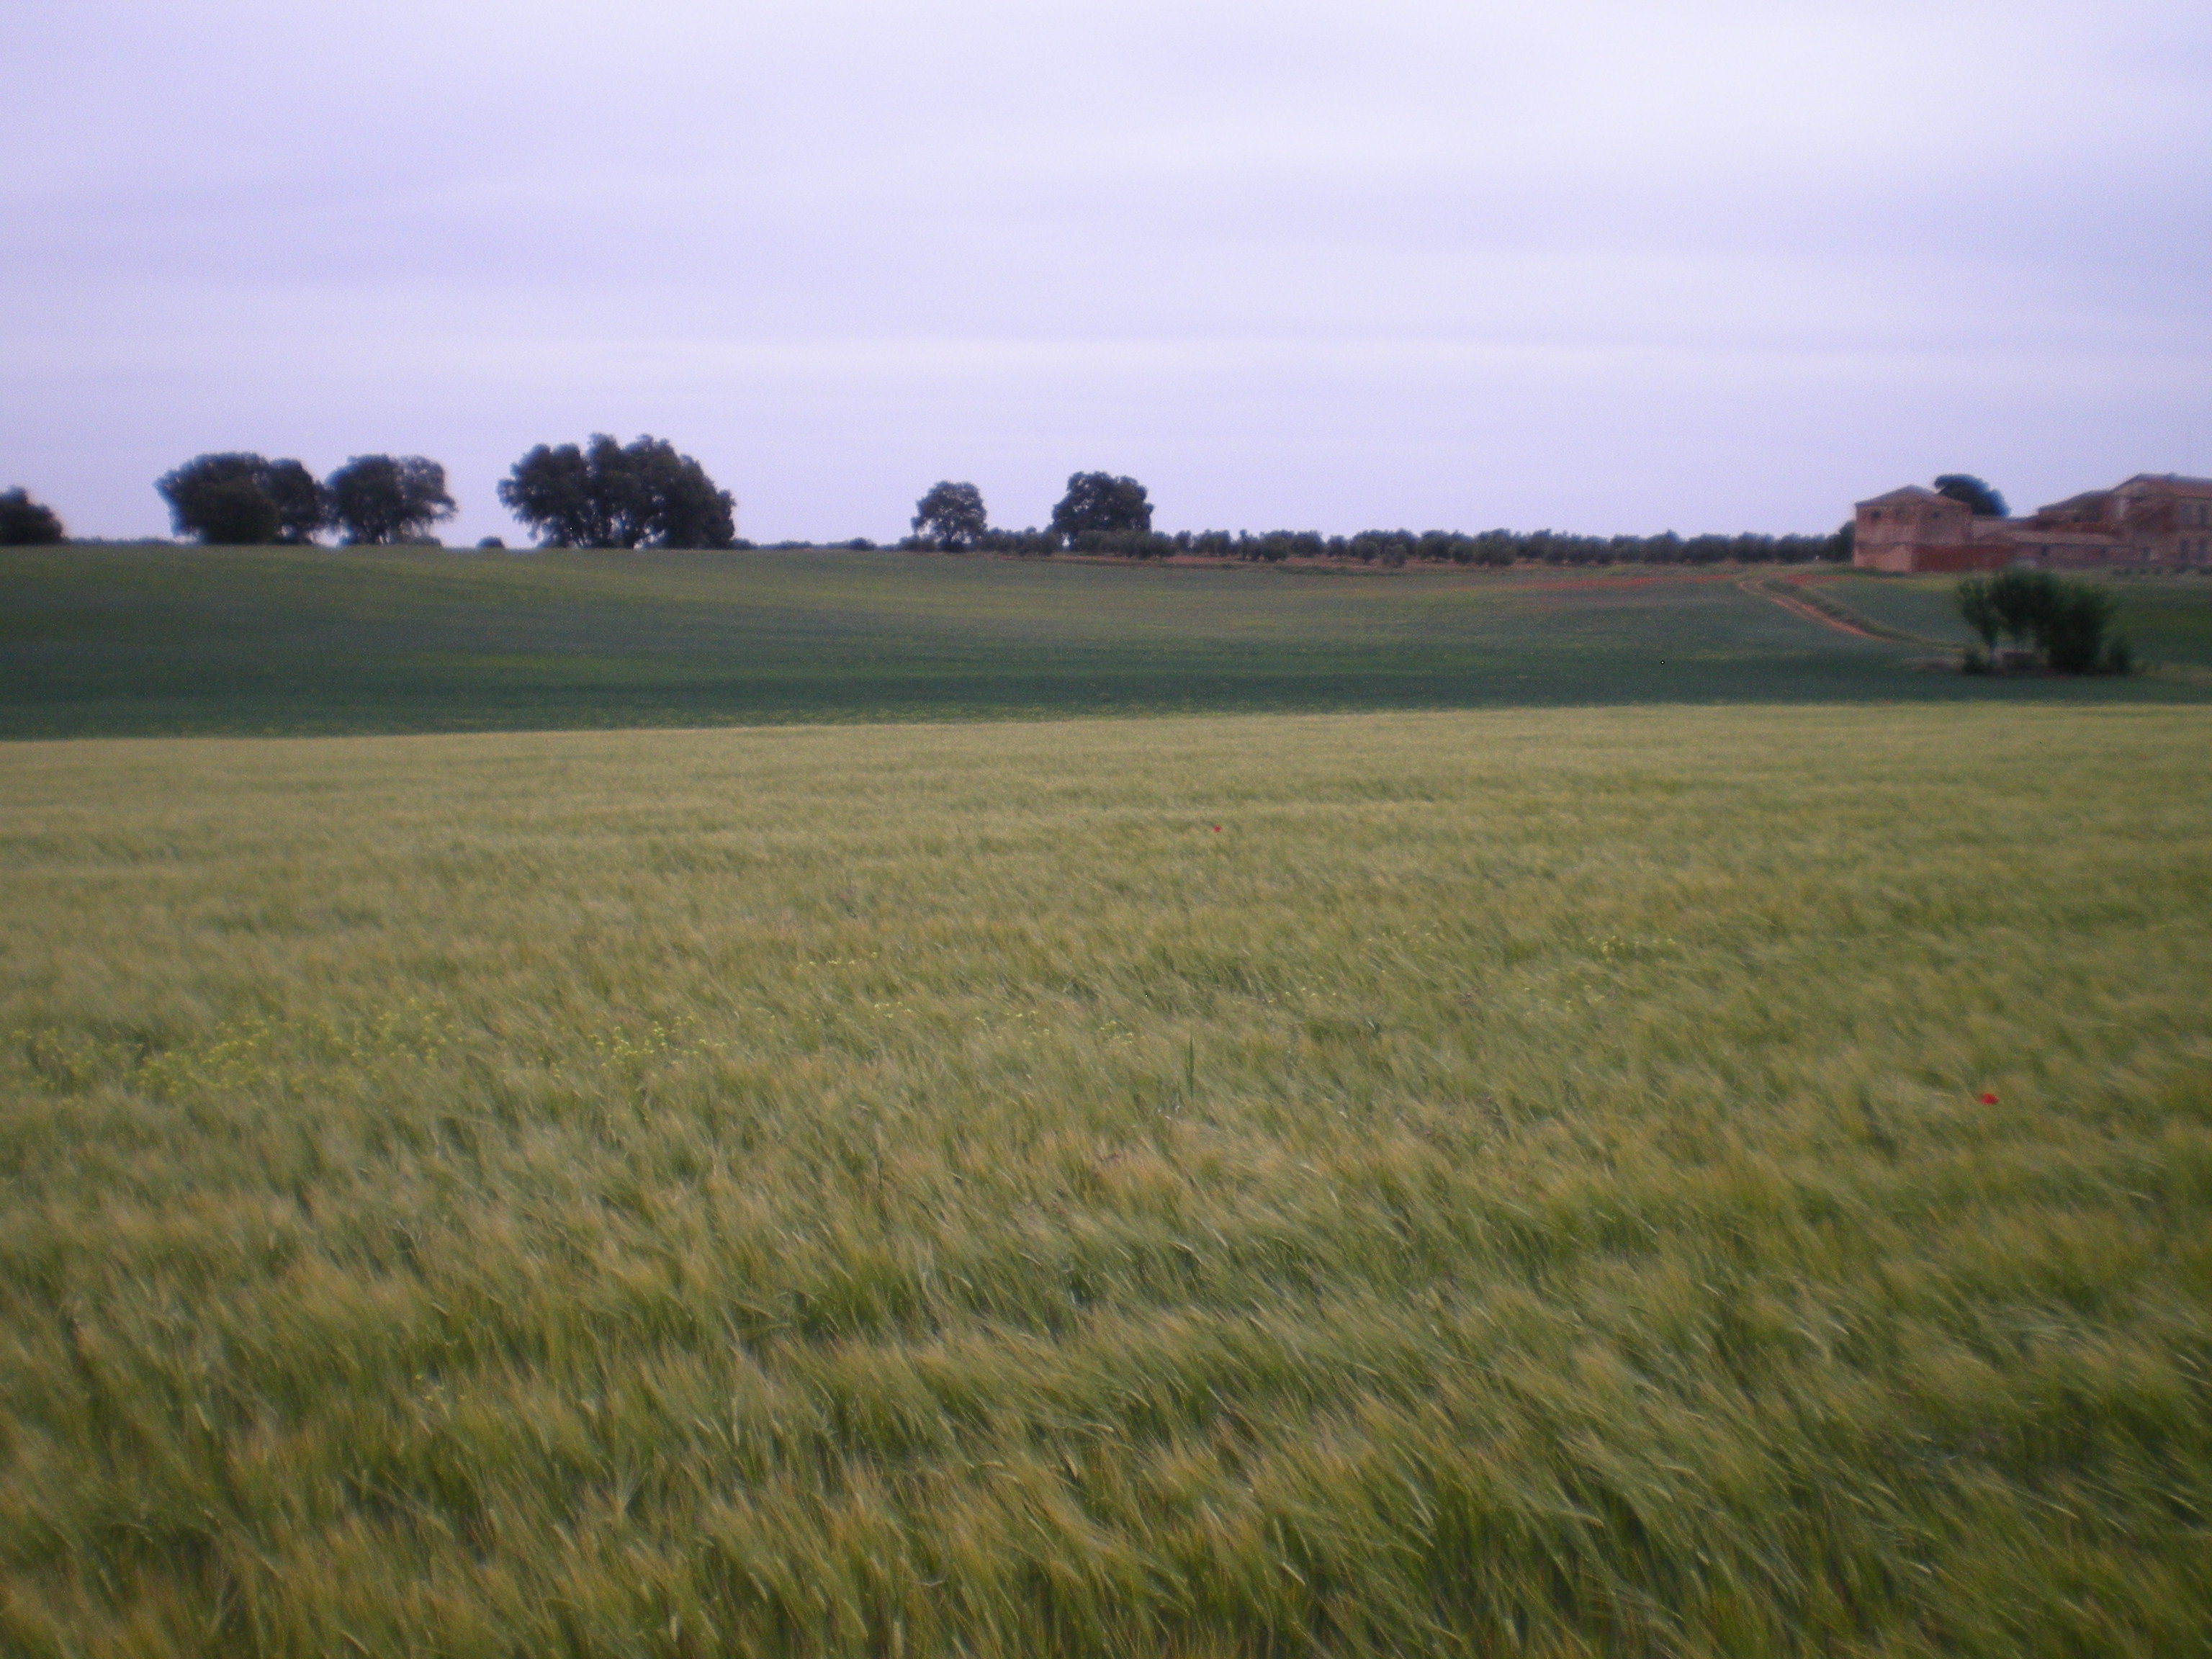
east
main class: Cropland
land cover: Barley
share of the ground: > 75 %
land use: Agriculture (excluding fallow land and kitchen gardens)
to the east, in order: Barley; Common wheat
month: May
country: ES
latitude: 38.6856
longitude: -3.1241
